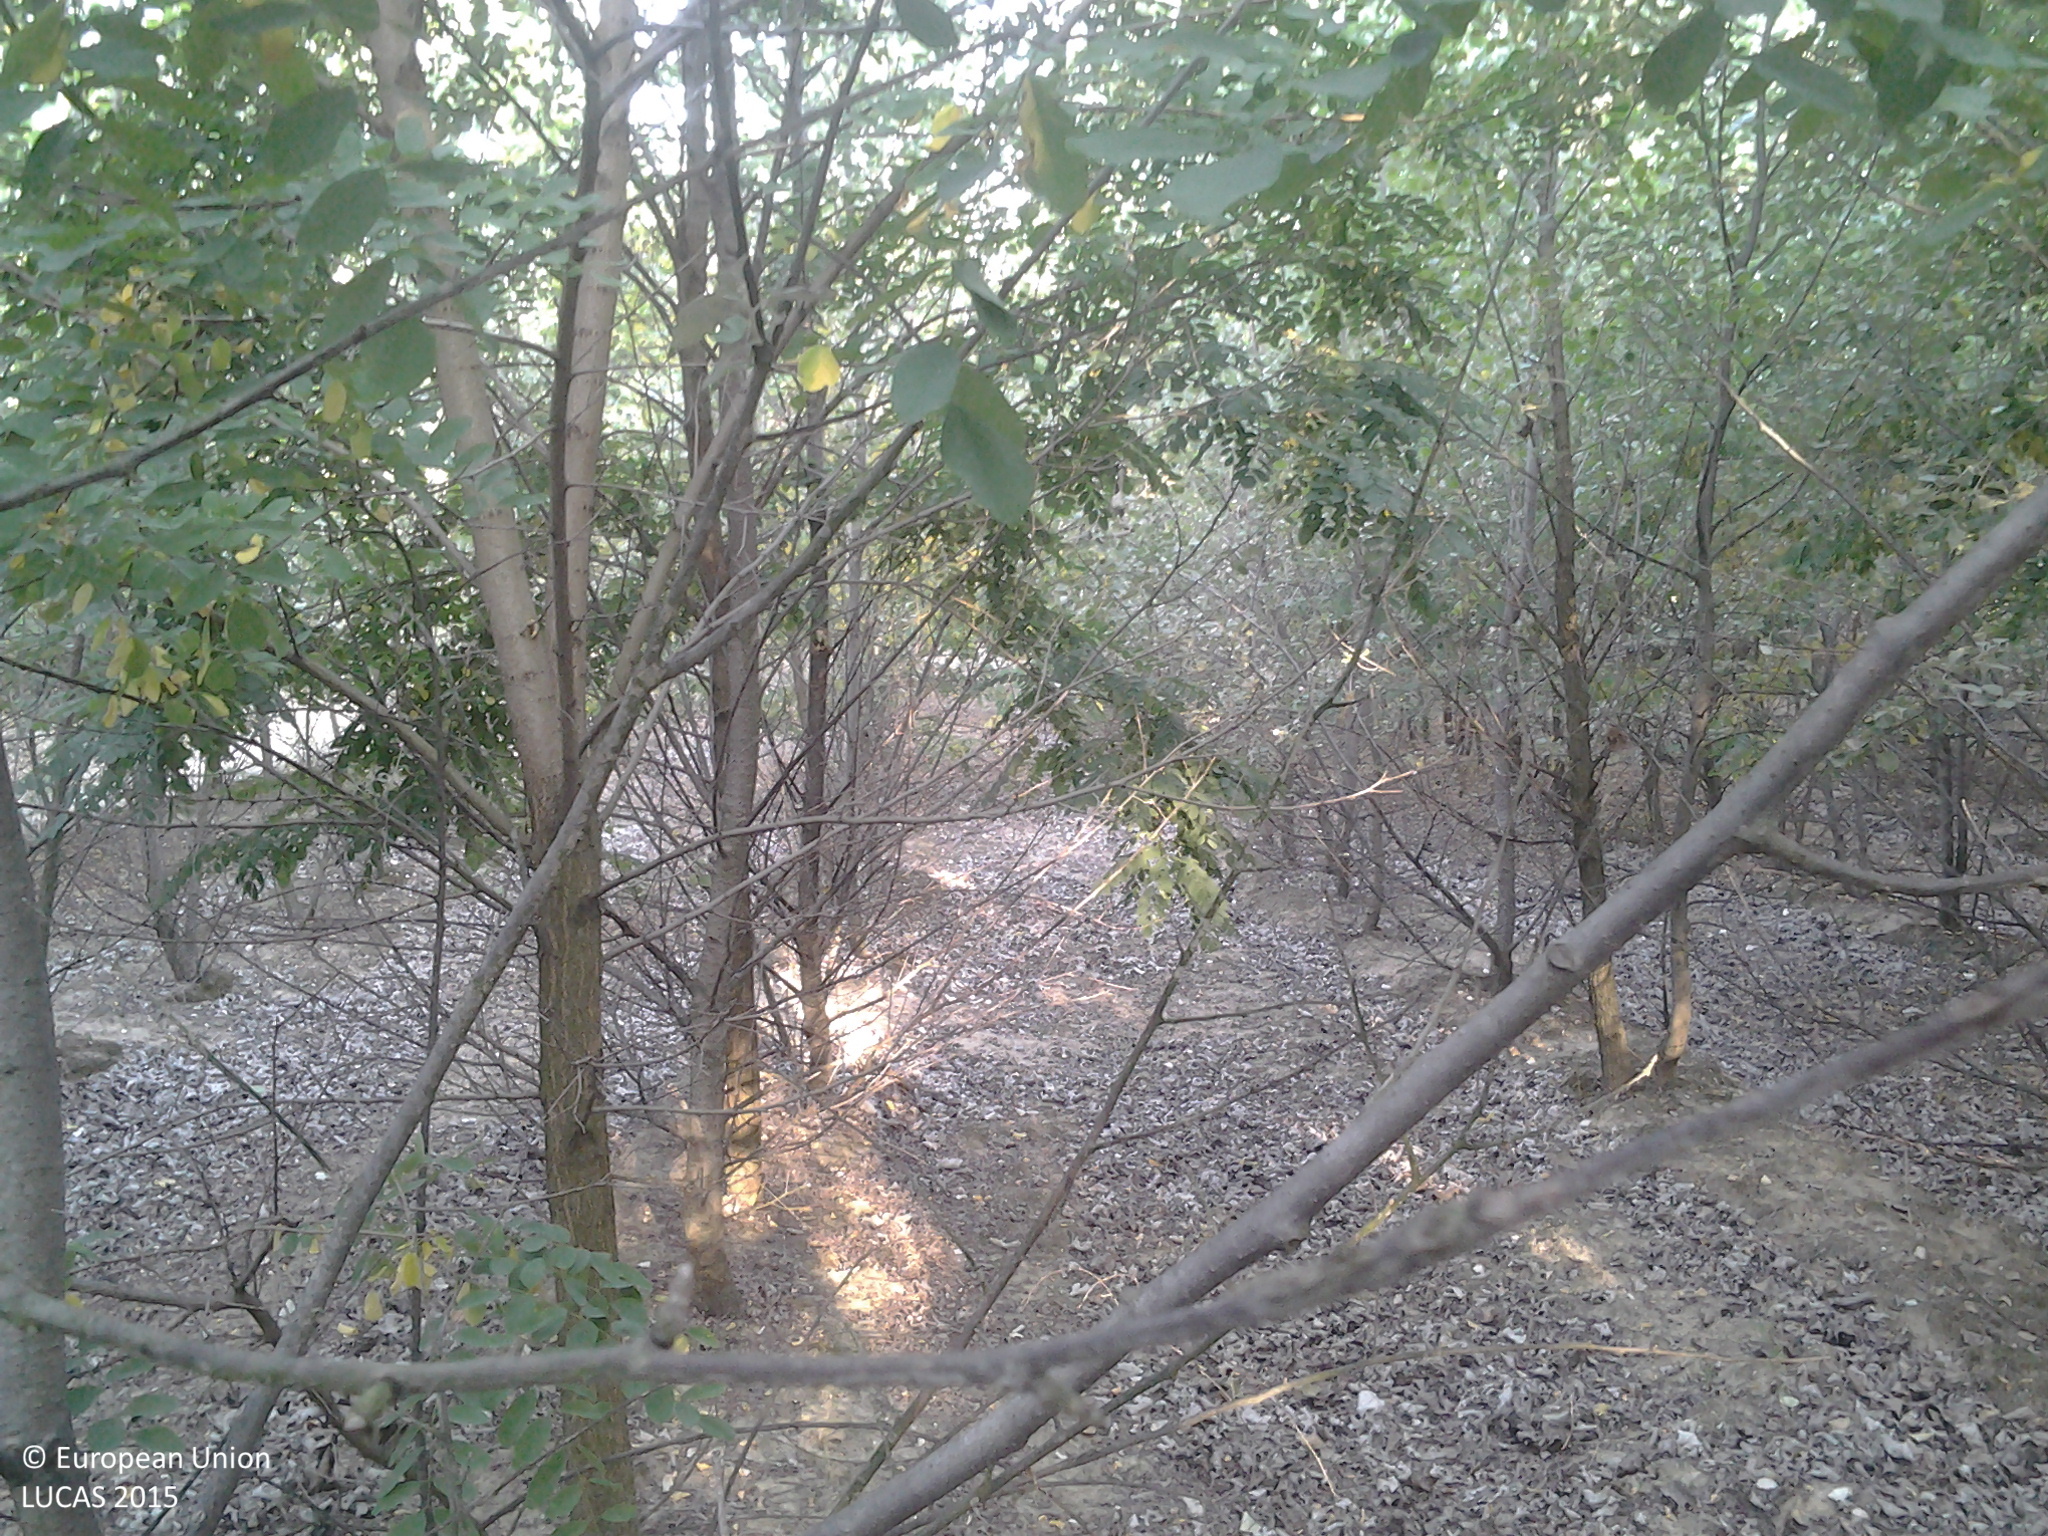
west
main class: Woodland
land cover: Broadleaved woodland
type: mesophytic deciduous forest
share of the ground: 50 - 75 %
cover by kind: broadleaved forest trees 100 %
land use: Forestry
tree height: > 5 m
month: July
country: HU
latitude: 46.9639
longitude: 19.2564
